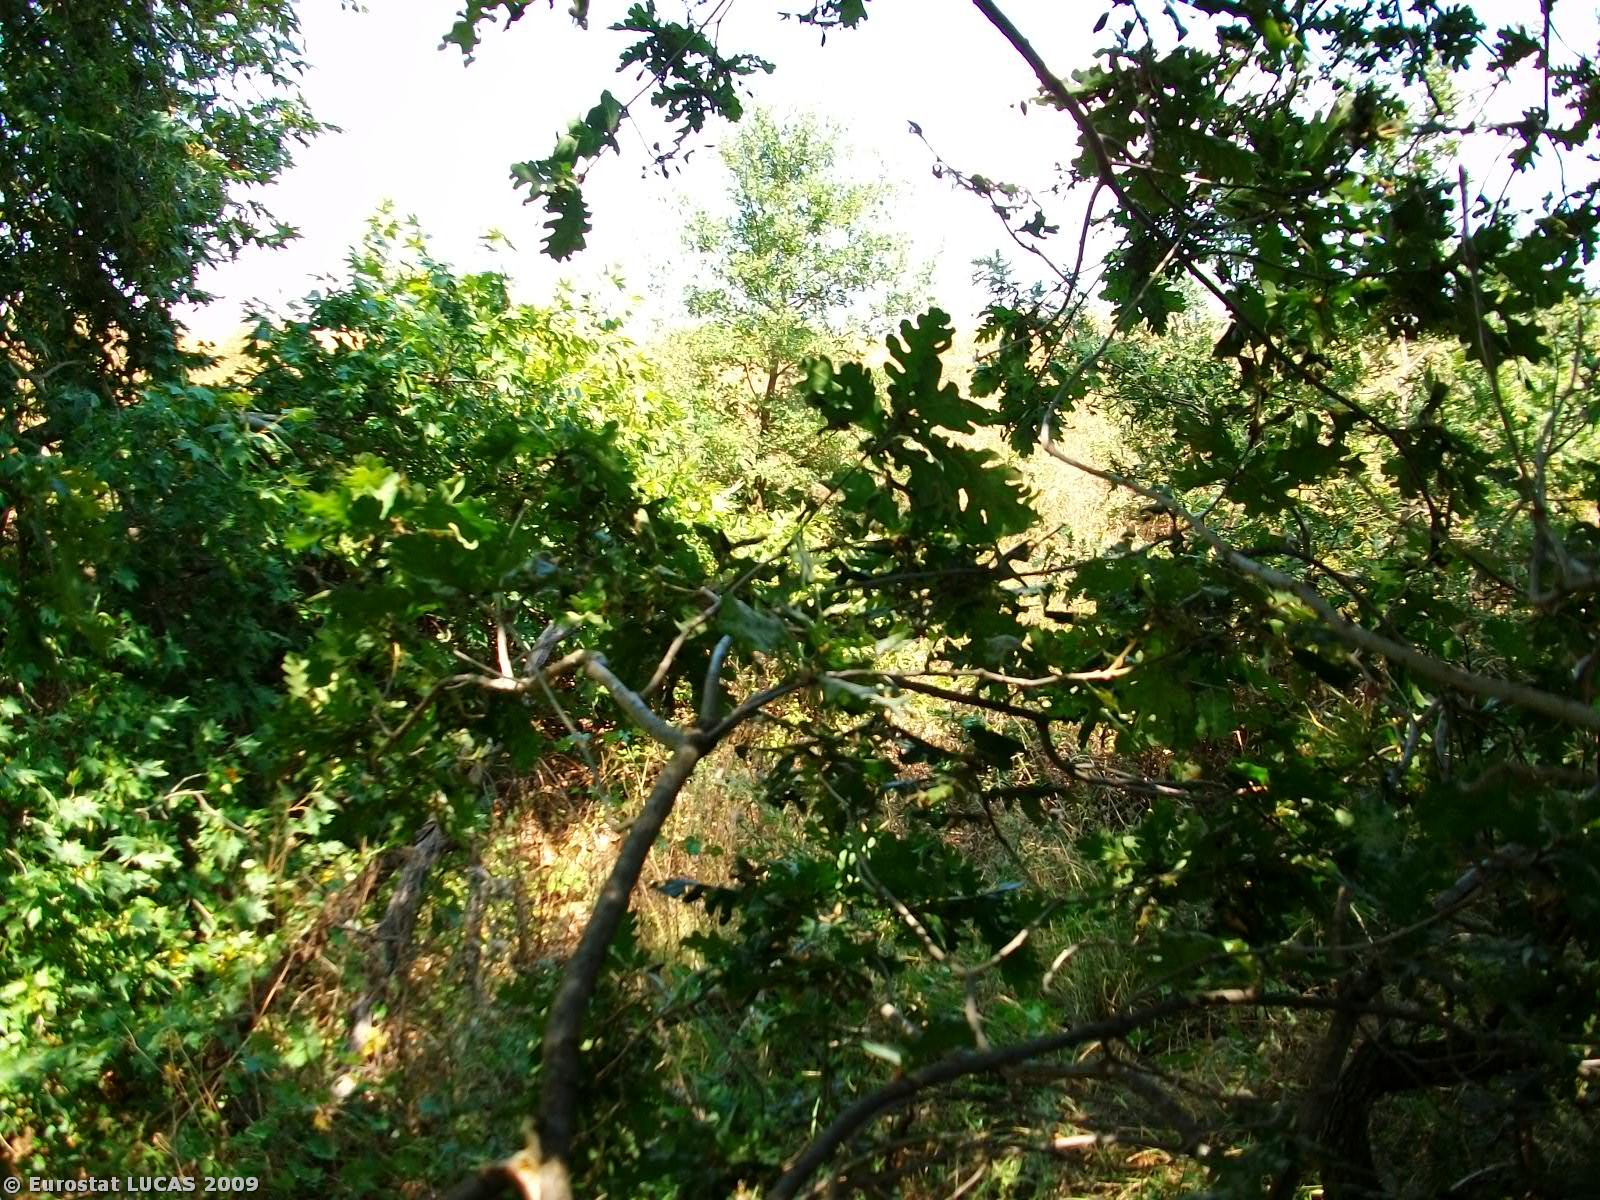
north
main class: Woodland
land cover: Broadleaved woodland
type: broadleaved evergreen forest
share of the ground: > 75 %
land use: Forestry
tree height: > 5 m
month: August
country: GR
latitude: 38.6812
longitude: 22.4736
